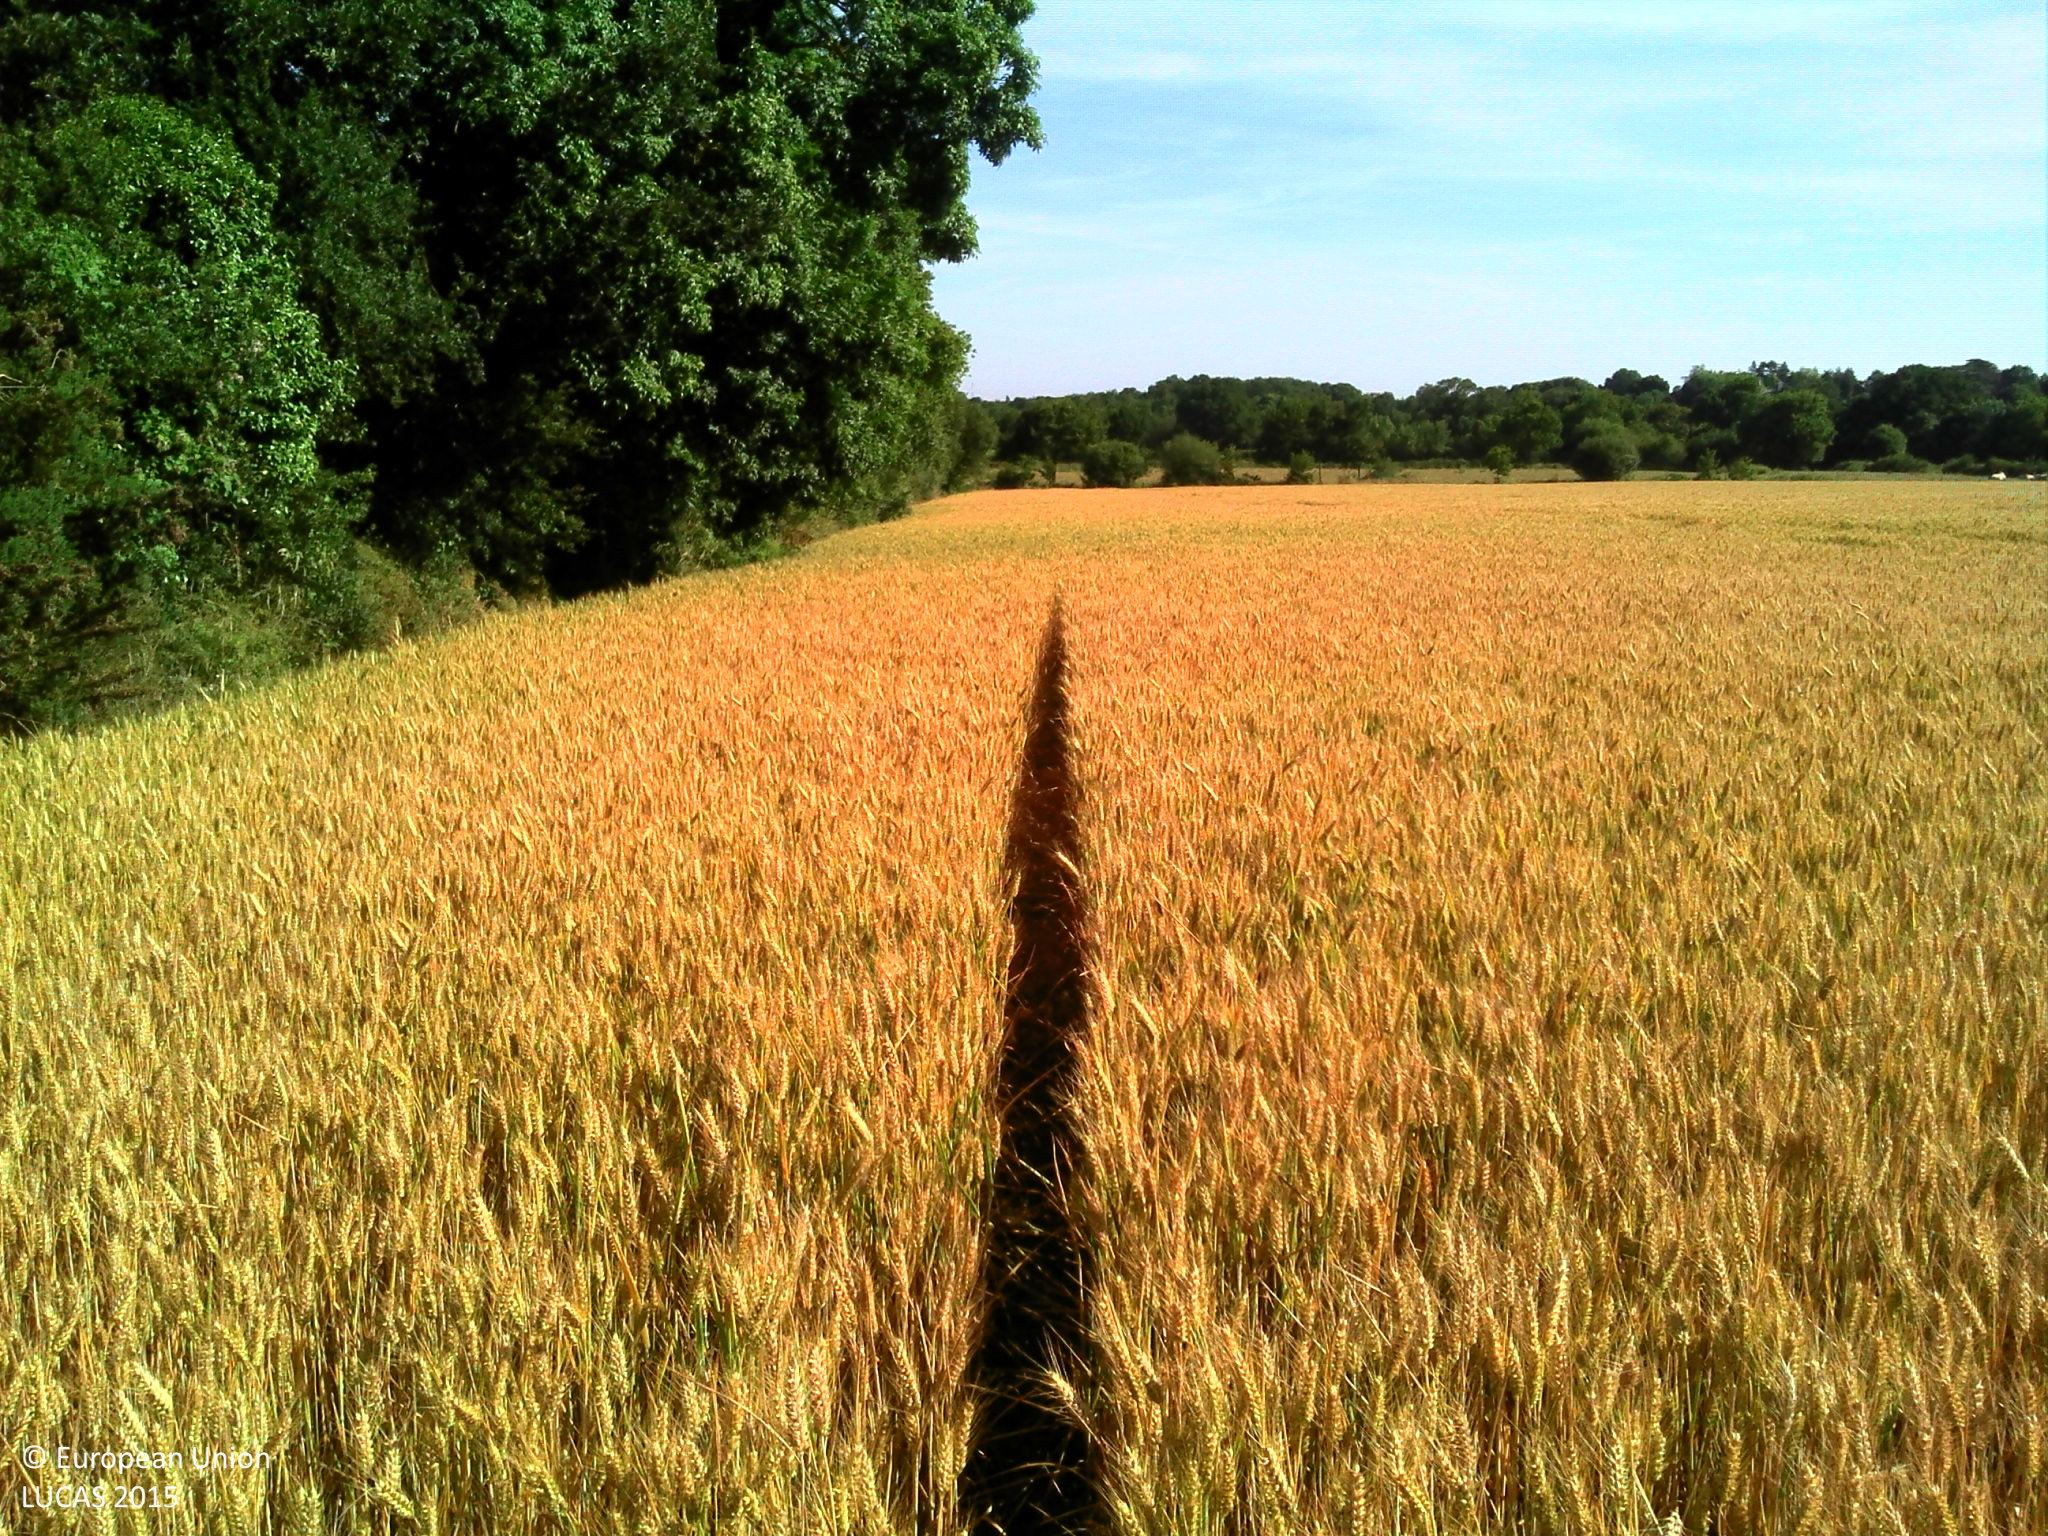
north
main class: Cropland
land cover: Common wheat
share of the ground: > 75 %
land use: Agriculture (excluding fallow land and kitchen gardens)
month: June
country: FR
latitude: 47.2494
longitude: -2.0594
